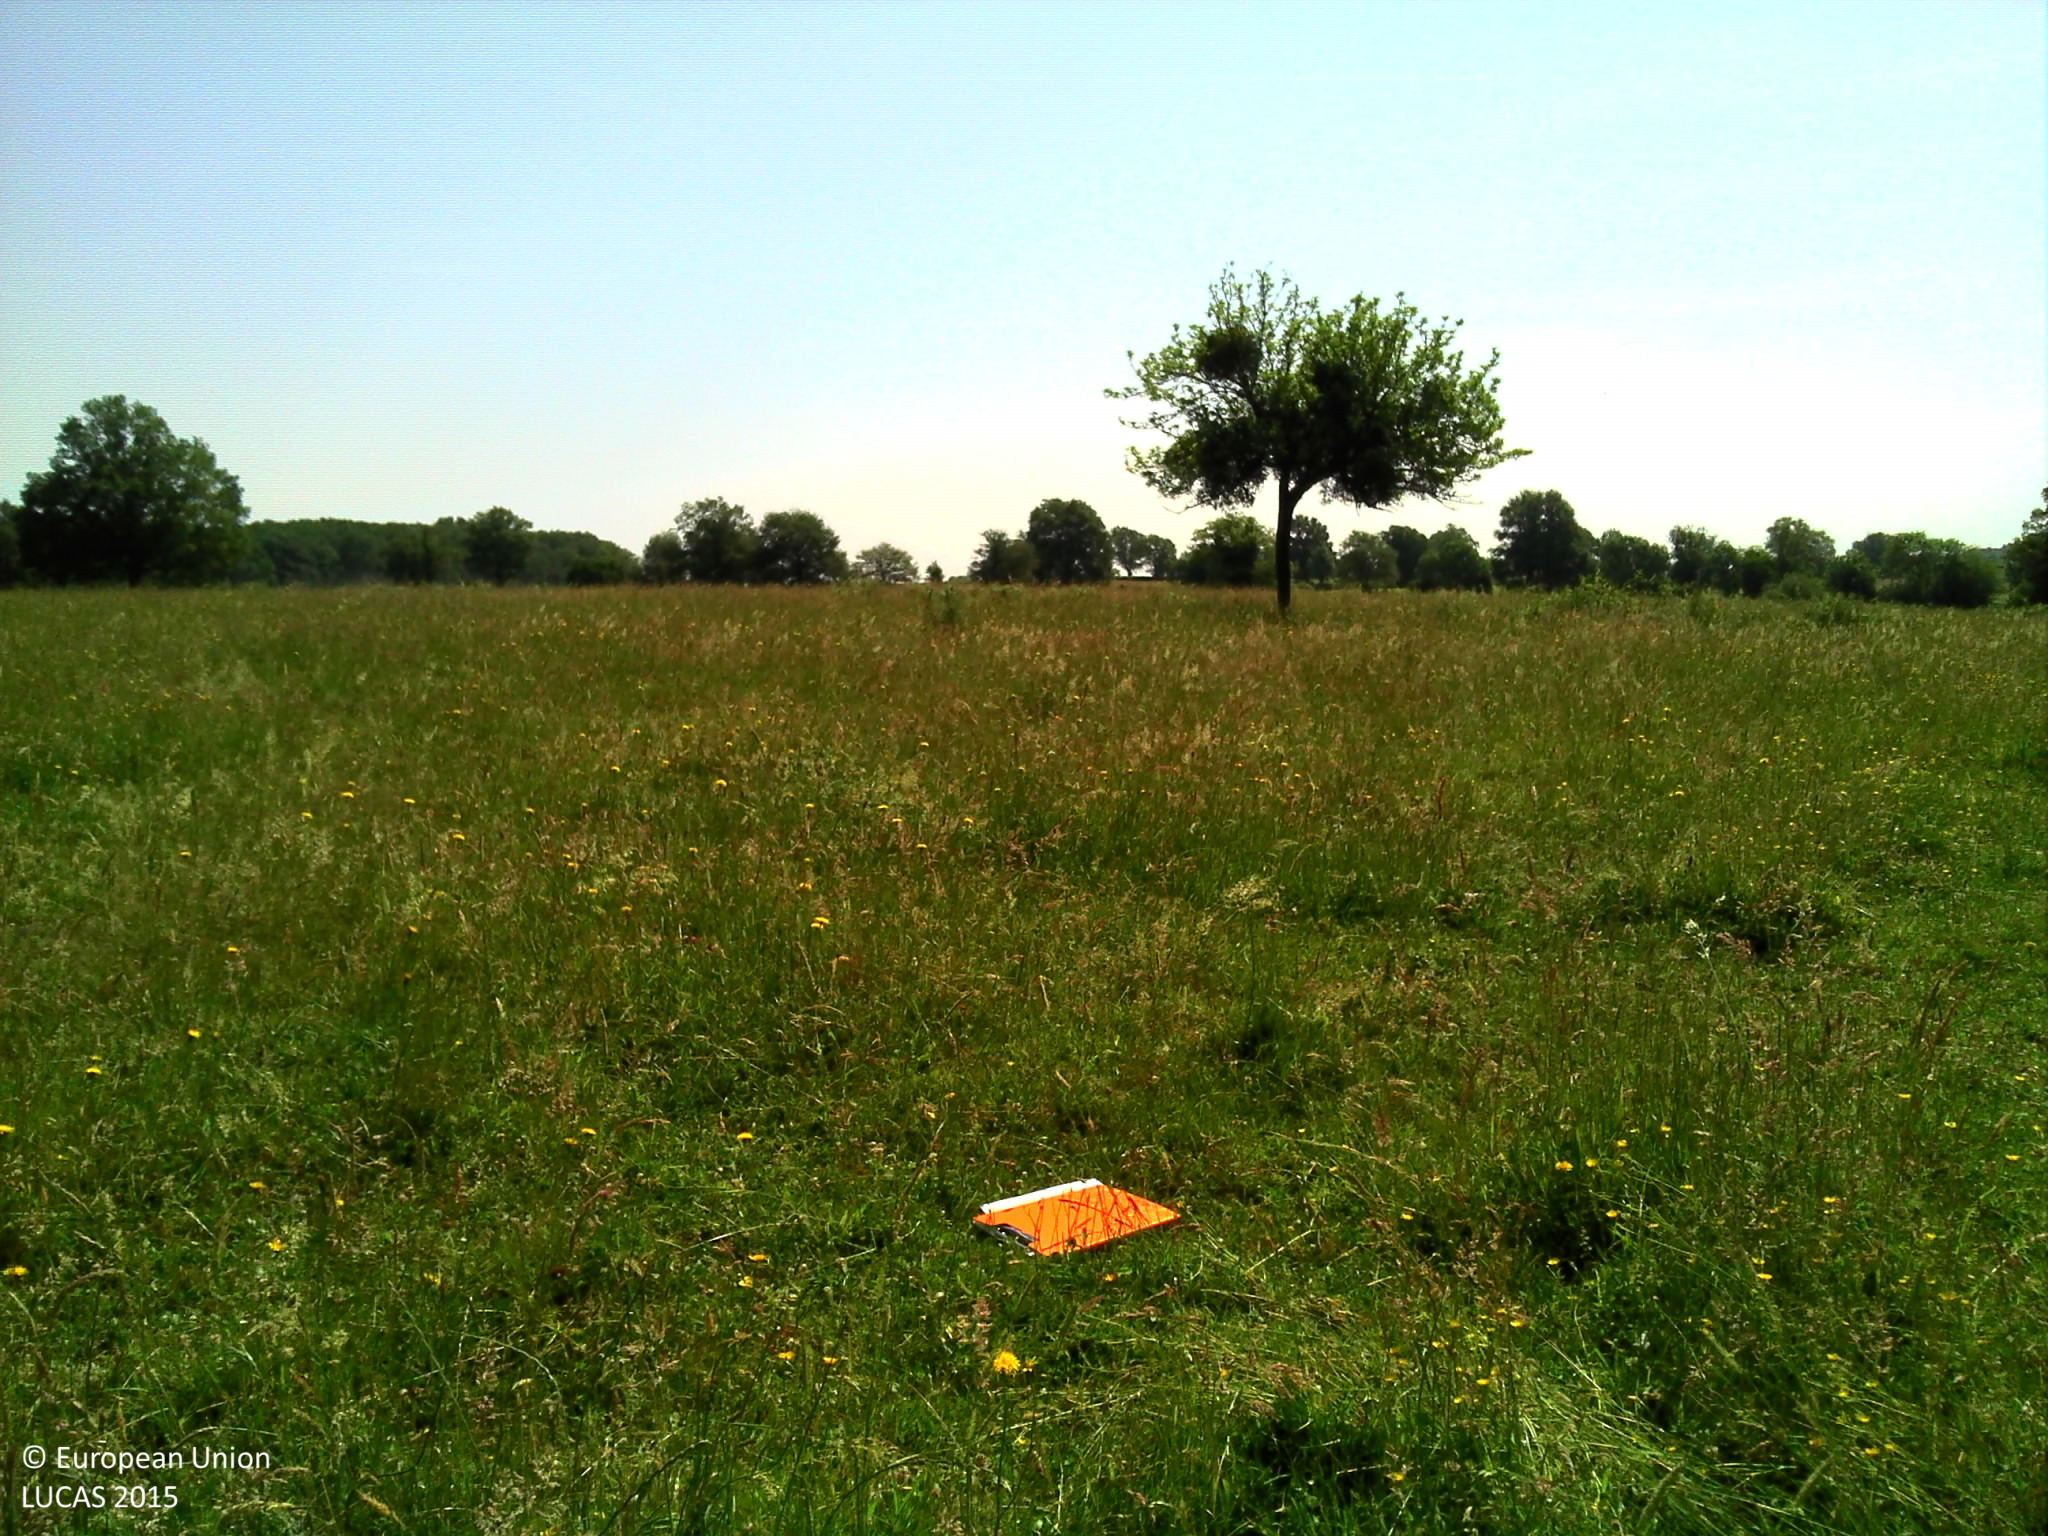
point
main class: Grassland
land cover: Grassland without tree/shrub cover
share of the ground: > 75 %
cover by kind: herbaceous plants 100 %
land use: Agriculture (excluding fallow land and kitchen gardens)
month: June
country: FR
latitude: 46.2350
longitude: 2.8003
